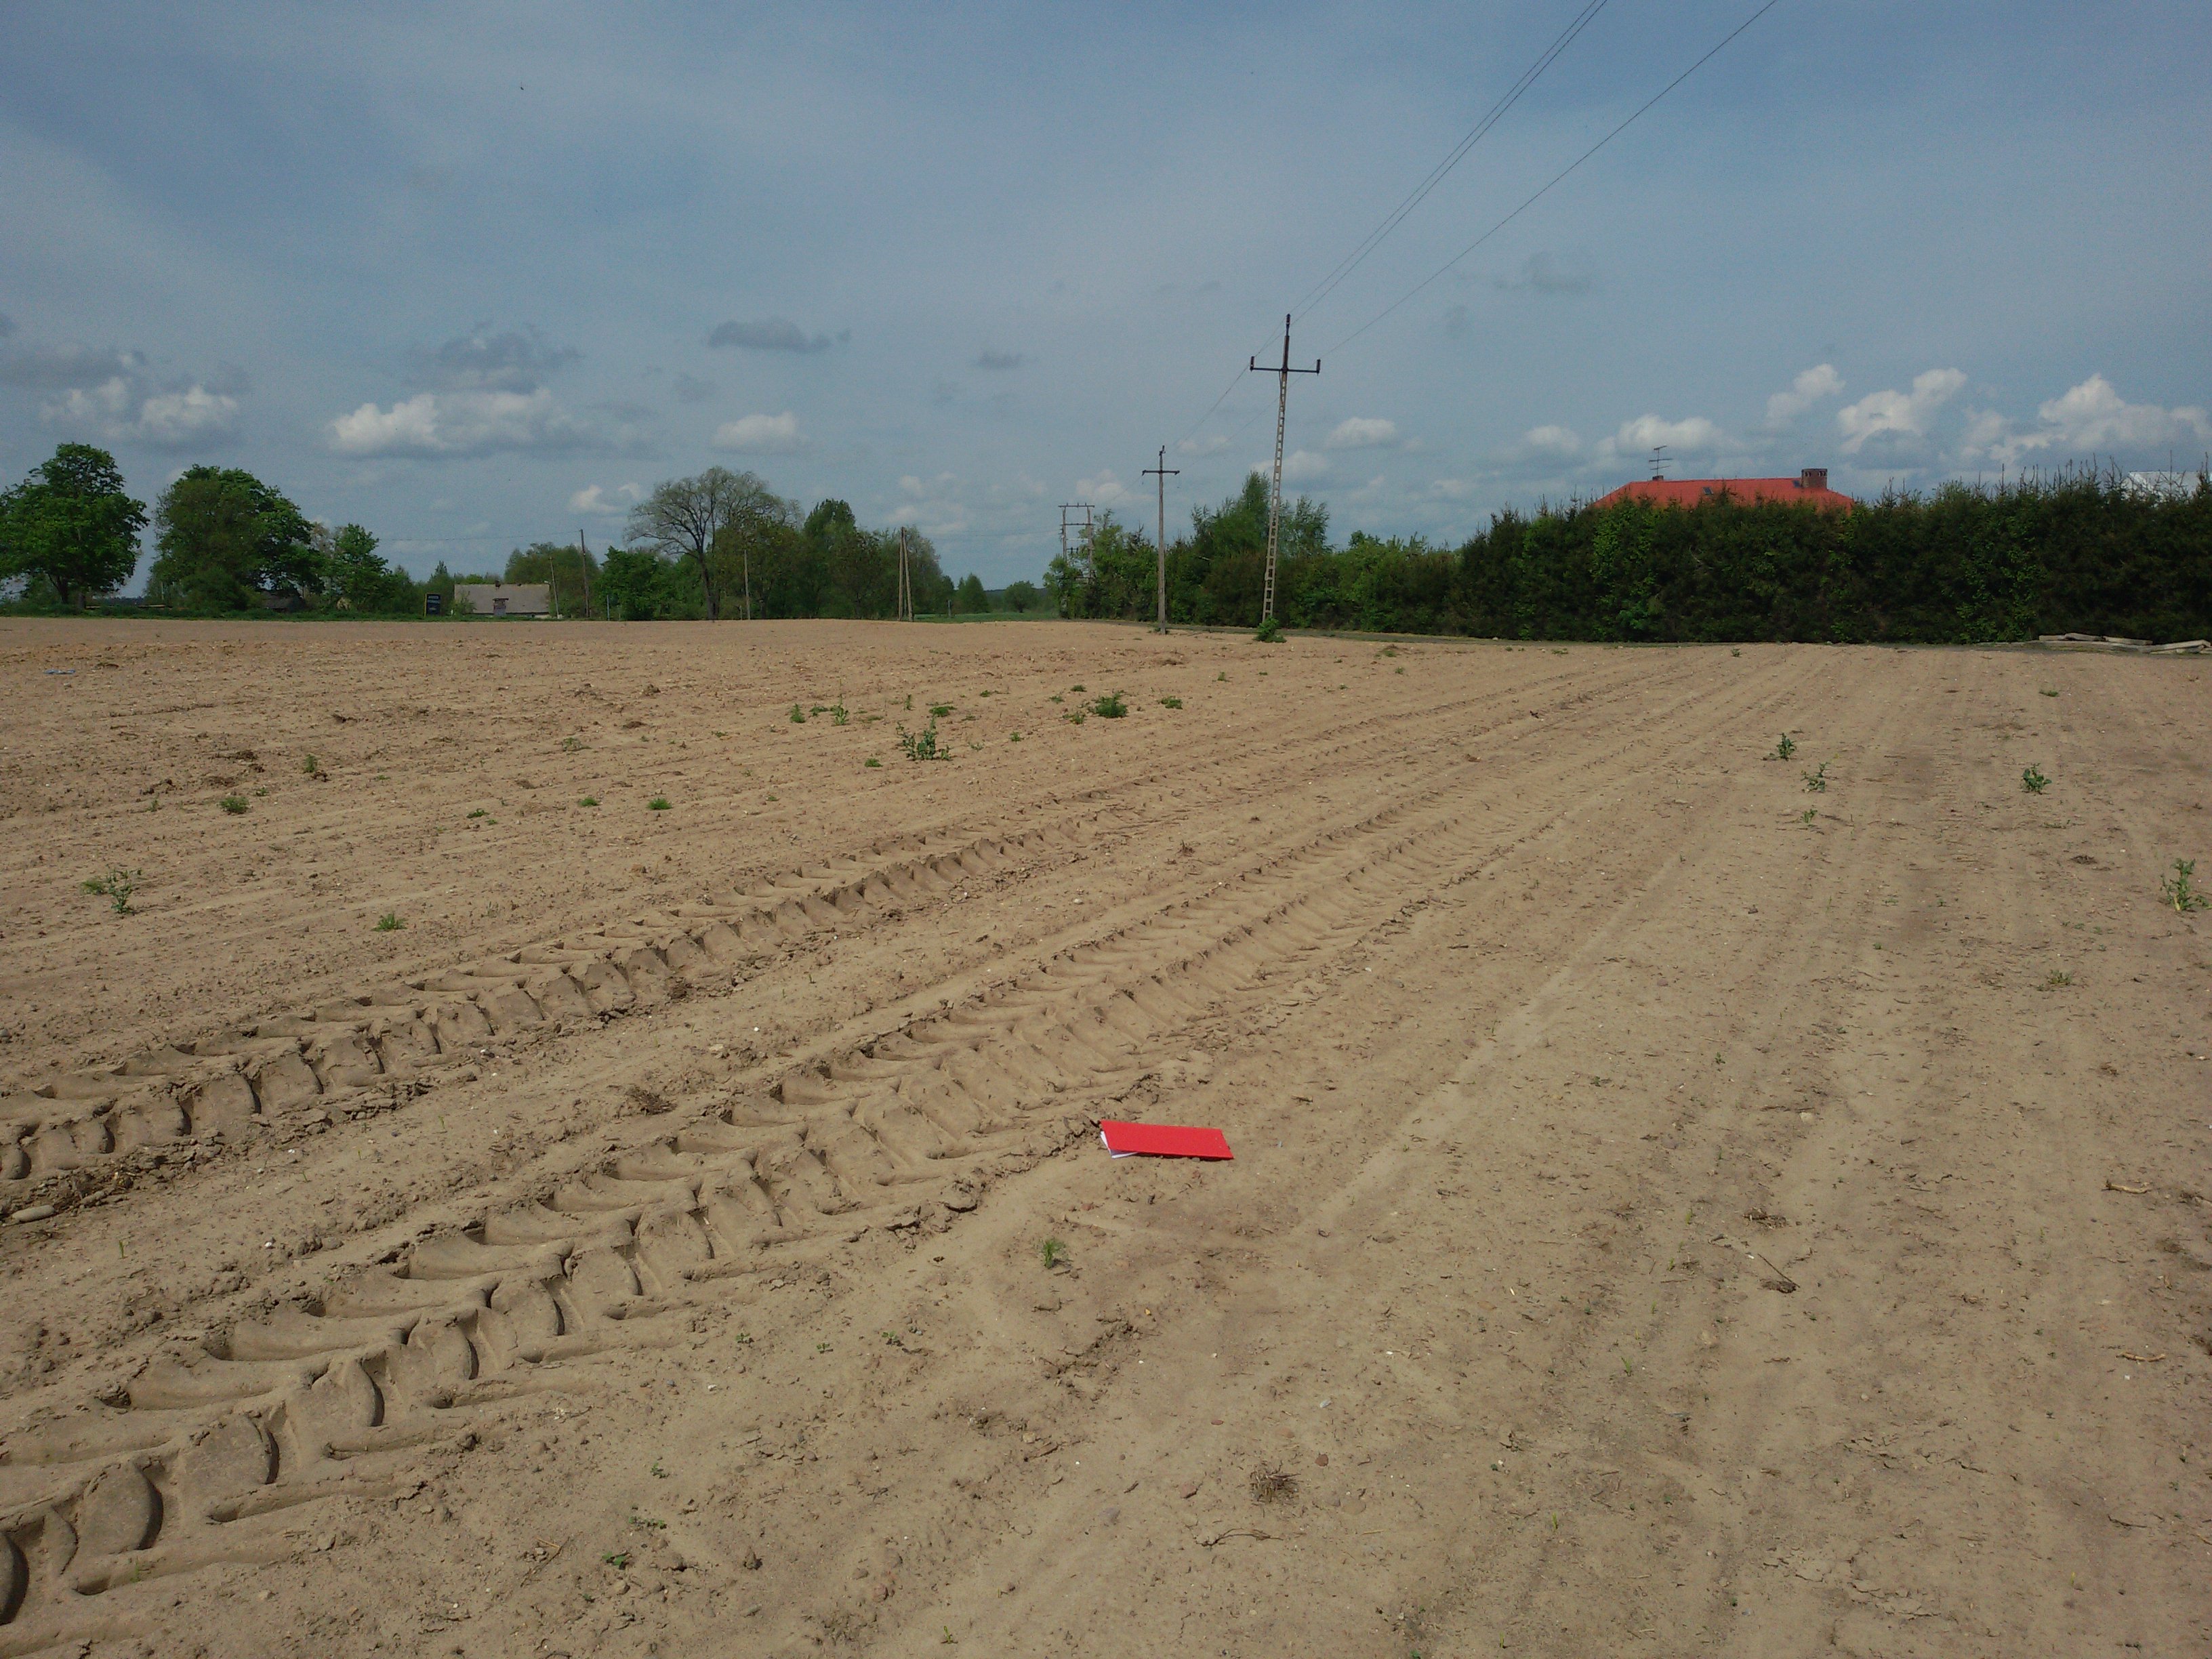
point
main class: Cropland
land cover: Common wheat
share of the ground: < 10 %
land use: Agriculture (excluding fallow land and kitchen gardens)
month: May
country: PL
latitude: 52.4841
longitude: 16.2353
